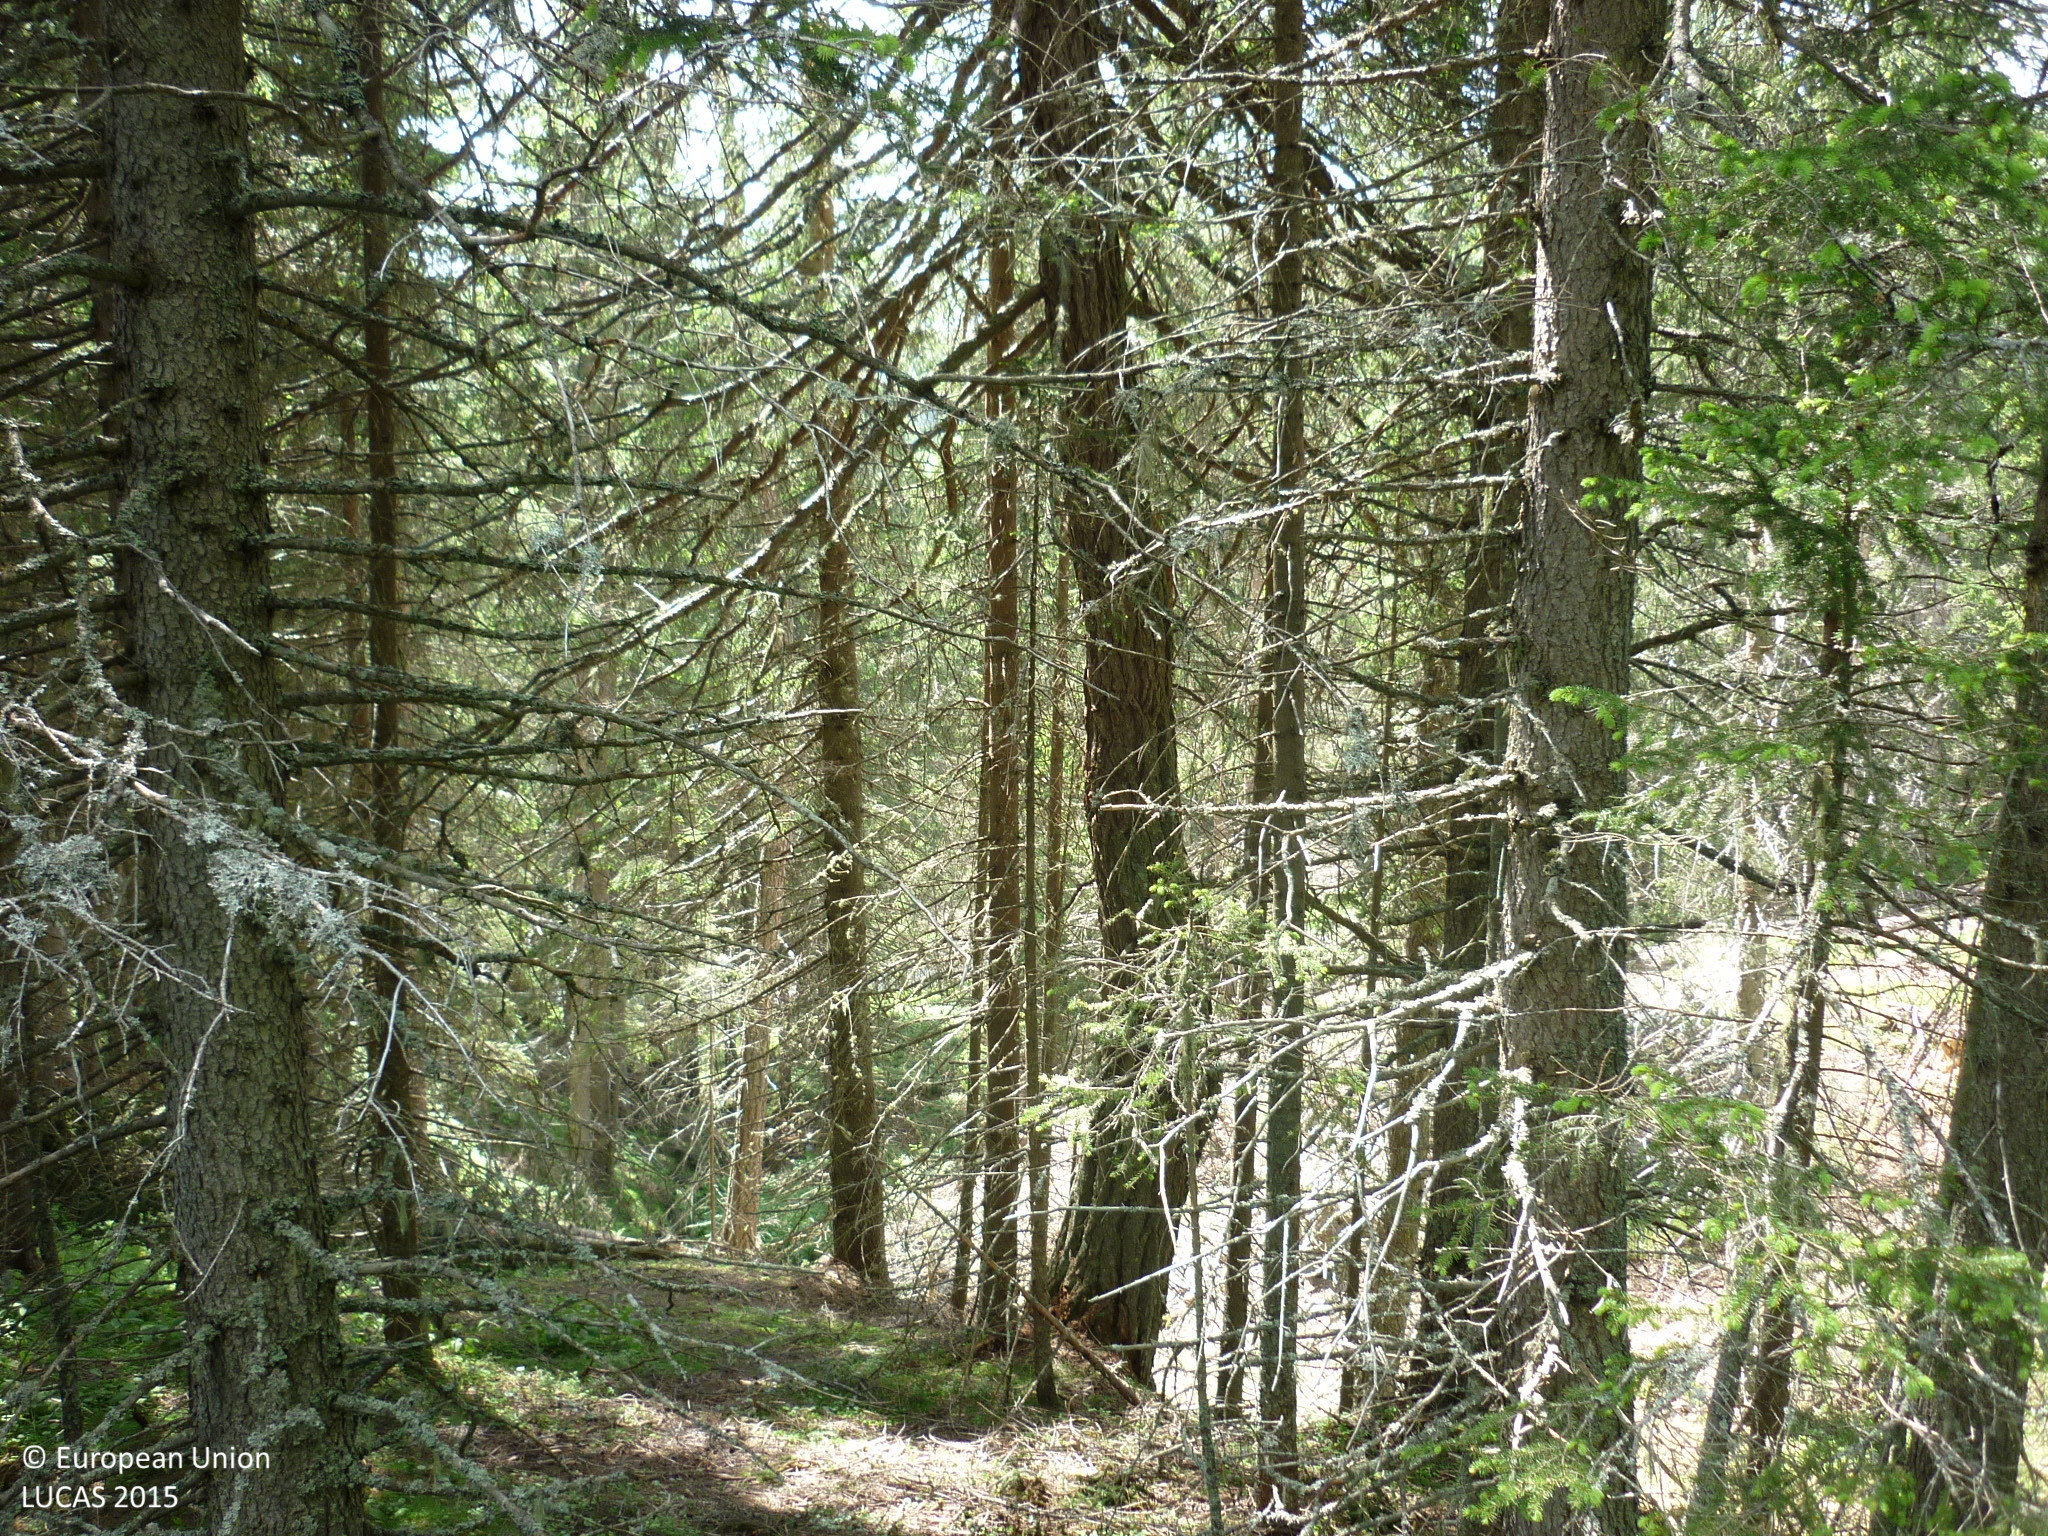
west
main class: Woodland
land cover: Spruce dominated coniferous woodland
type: alpine coniferous forest
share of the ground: > 75 %
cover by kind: coniferous forest trees 80 %, herbaceous plants 15 %, unconsolidated bare surface 5 %
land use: Forestry
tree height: > 5 m
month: June
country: AT
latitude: 47.2537
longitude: 14.3723
